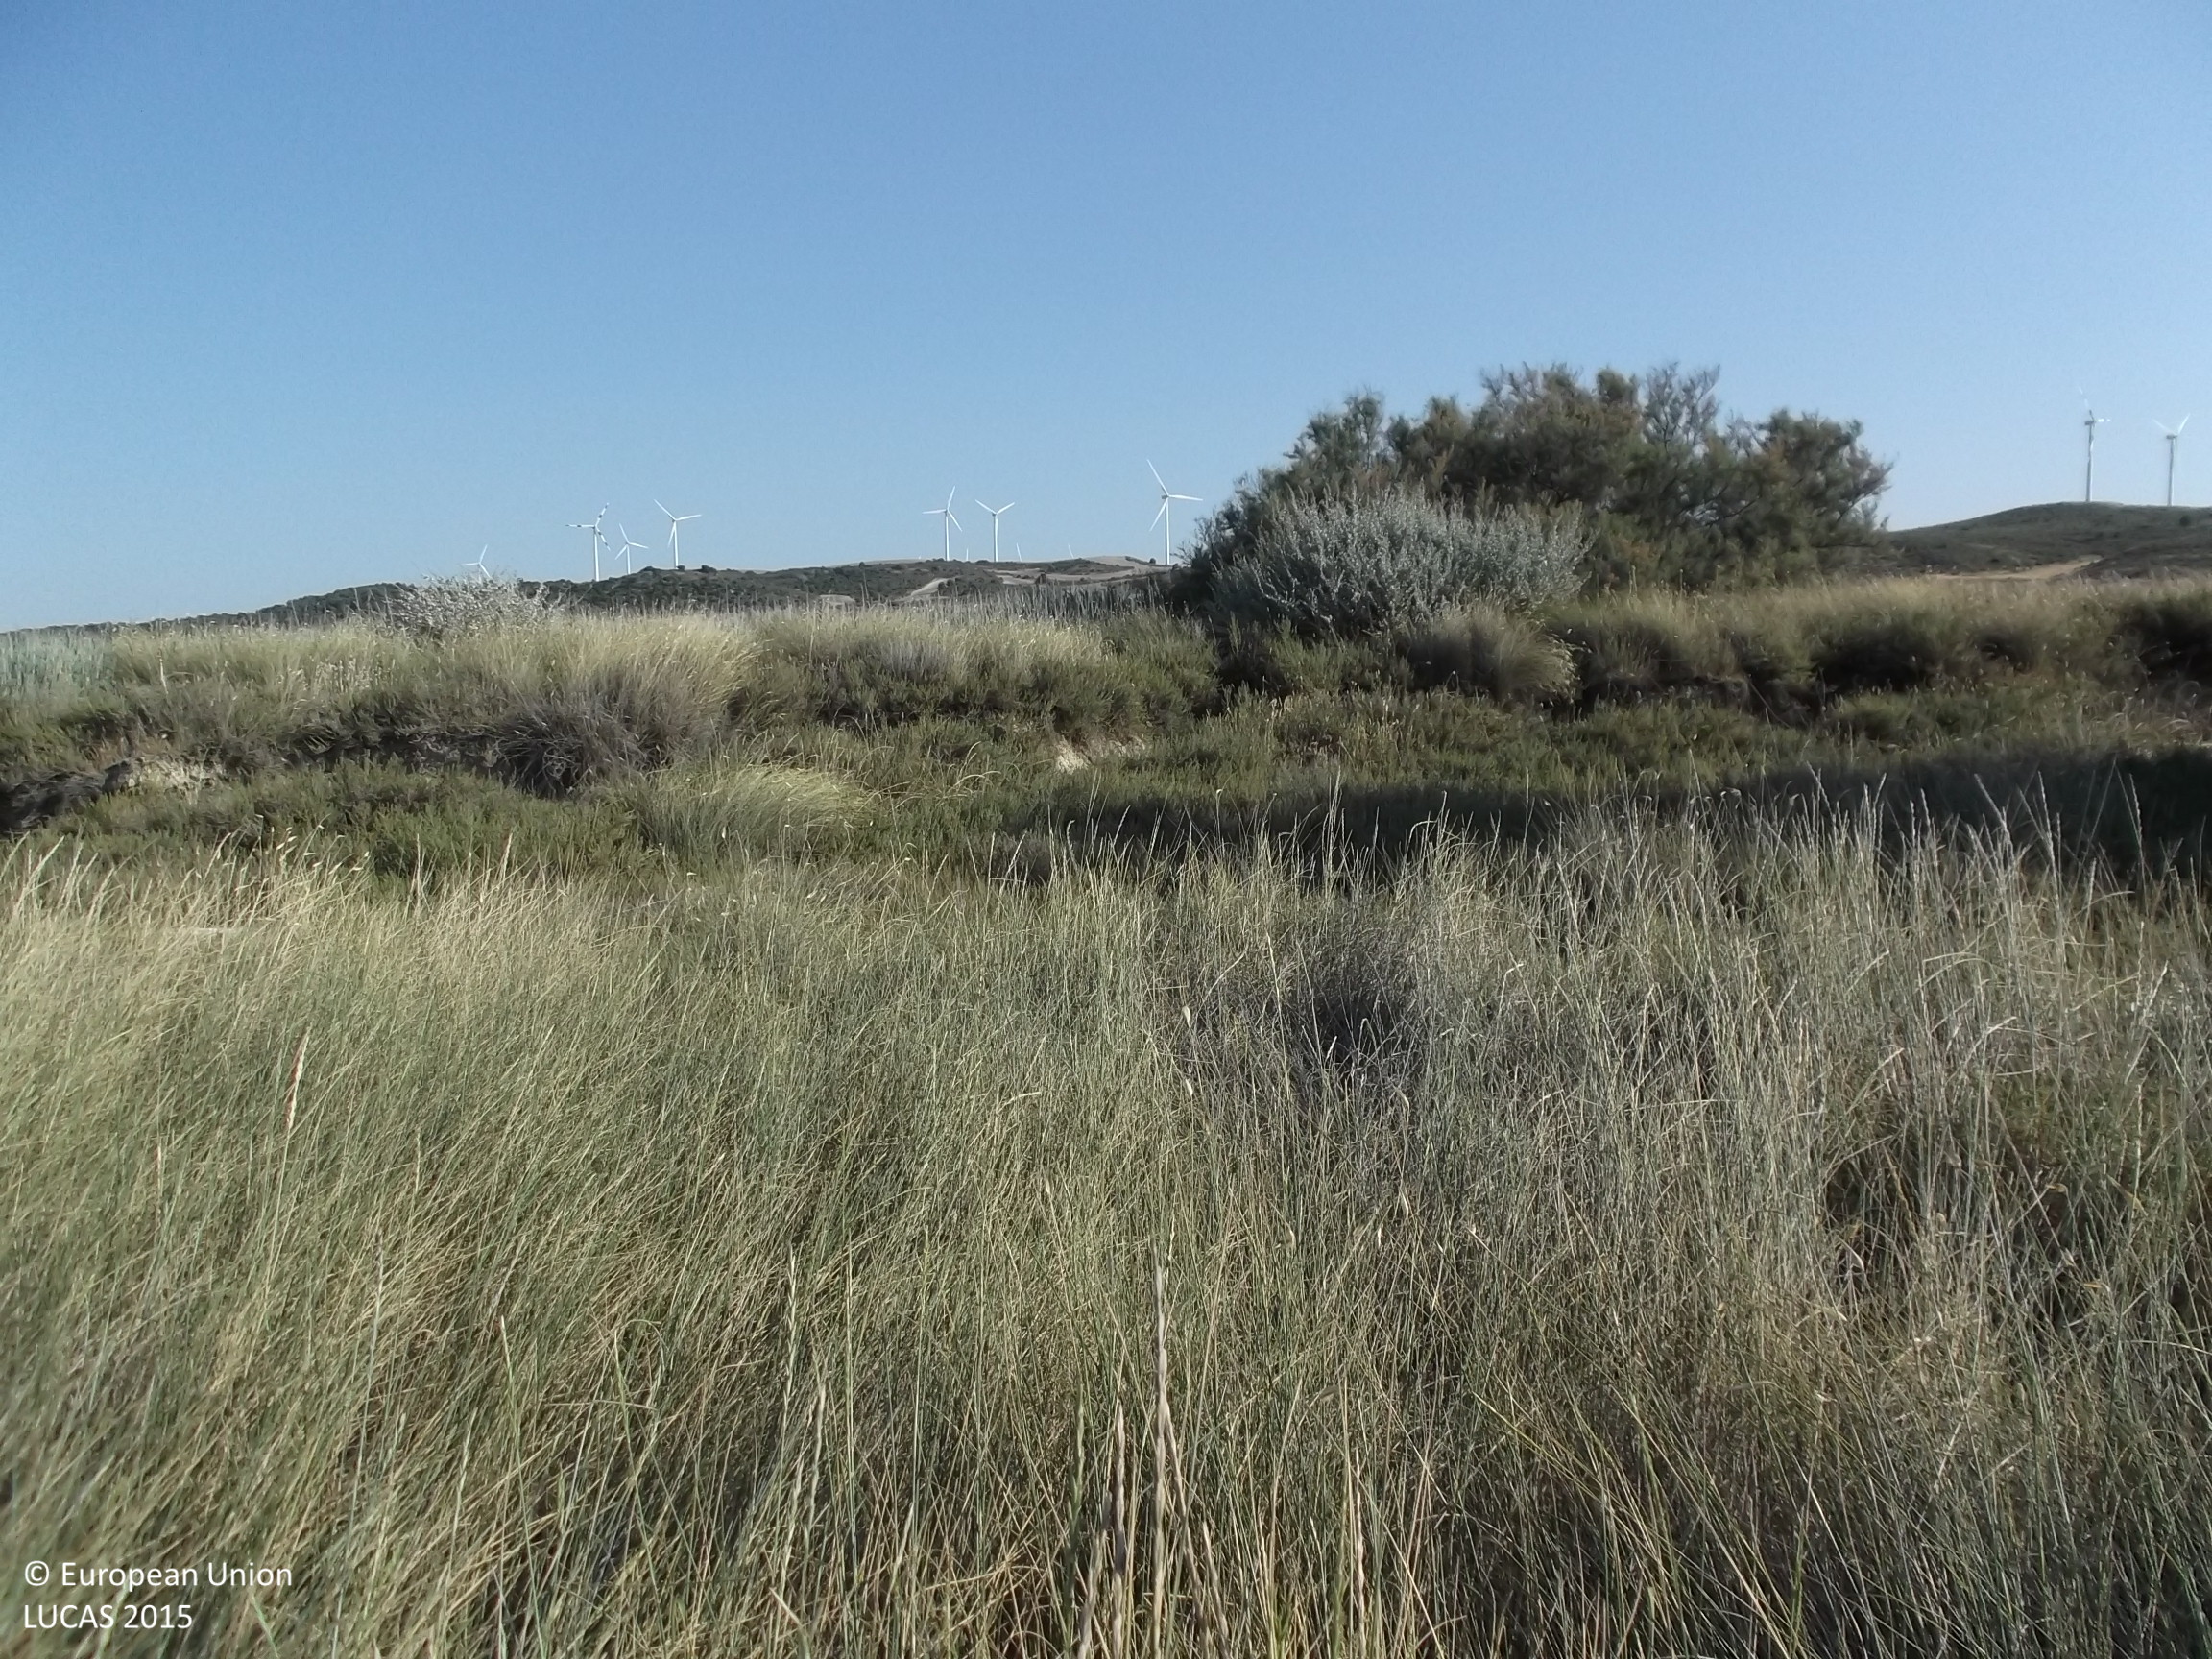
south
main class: Grassland
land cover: Grassland without tree/shrub cover
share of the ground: > 75 %
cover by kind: herbaceous plants 95 %
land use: Semi-natural and natural areas not in use
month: July
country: ES
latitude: 42.3109
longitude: -1.6204
